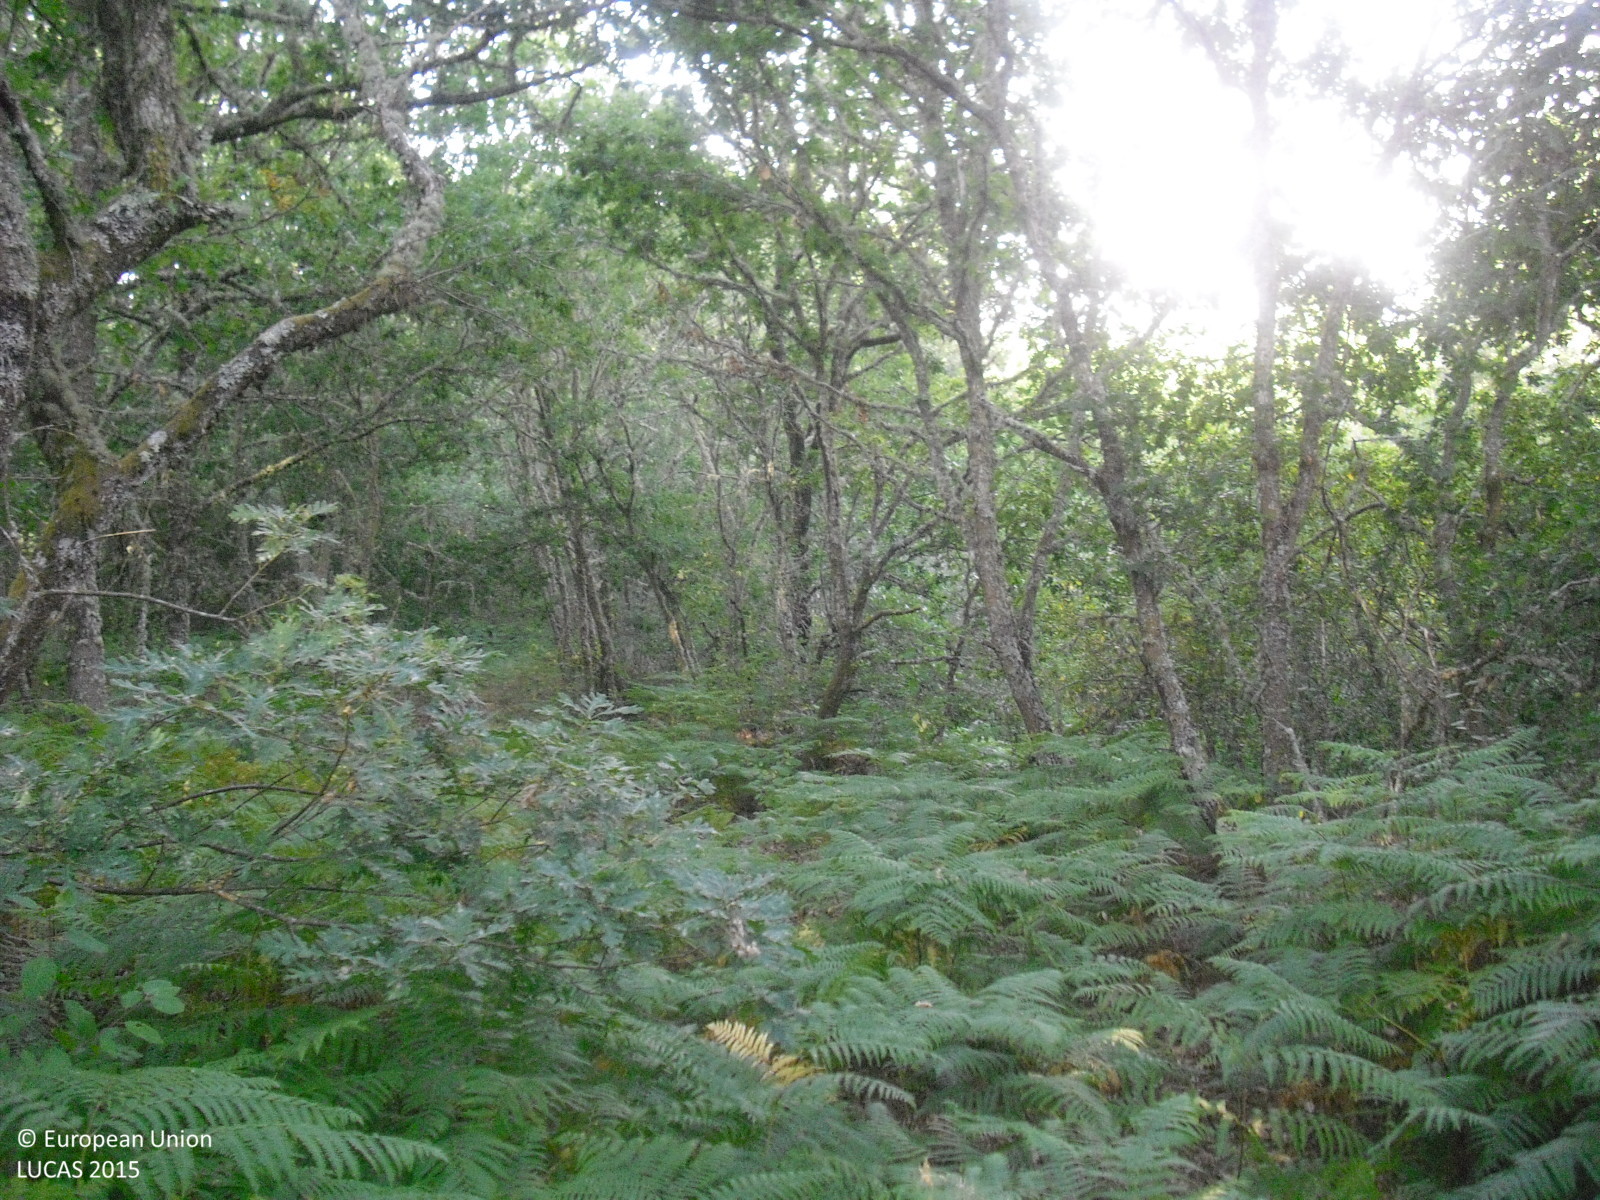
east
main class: Woodland
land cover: Pine dominated mixed woodland
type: hemiboreal forest and nemoral coniferous forest and mixed broadleaved-coniferous forest
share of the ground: > 75 %
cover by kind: broadleaved forest trees 60 %, coniferous forest trees 20 %, shrubs 20 %
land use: Forestry
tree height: > 5 m
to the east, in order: Pine dominated mixed woodland; Dry stone walls; Broadleaved woodland; Rivers and streams; Dry stone walls; Shrubland with sparse tree cover; Dry stone walls; Broadleaved woodland; Dry stone walls; Pine dominated mixed woodland; Dry stone walls; Pine dominated mixed woodland; Shrubland without tree cover; Pine dominated mixed woodland; Dry stone walls; Pine dominated coniferous woodland
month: July
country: ES
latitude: 42.3075
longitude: -7.7488
